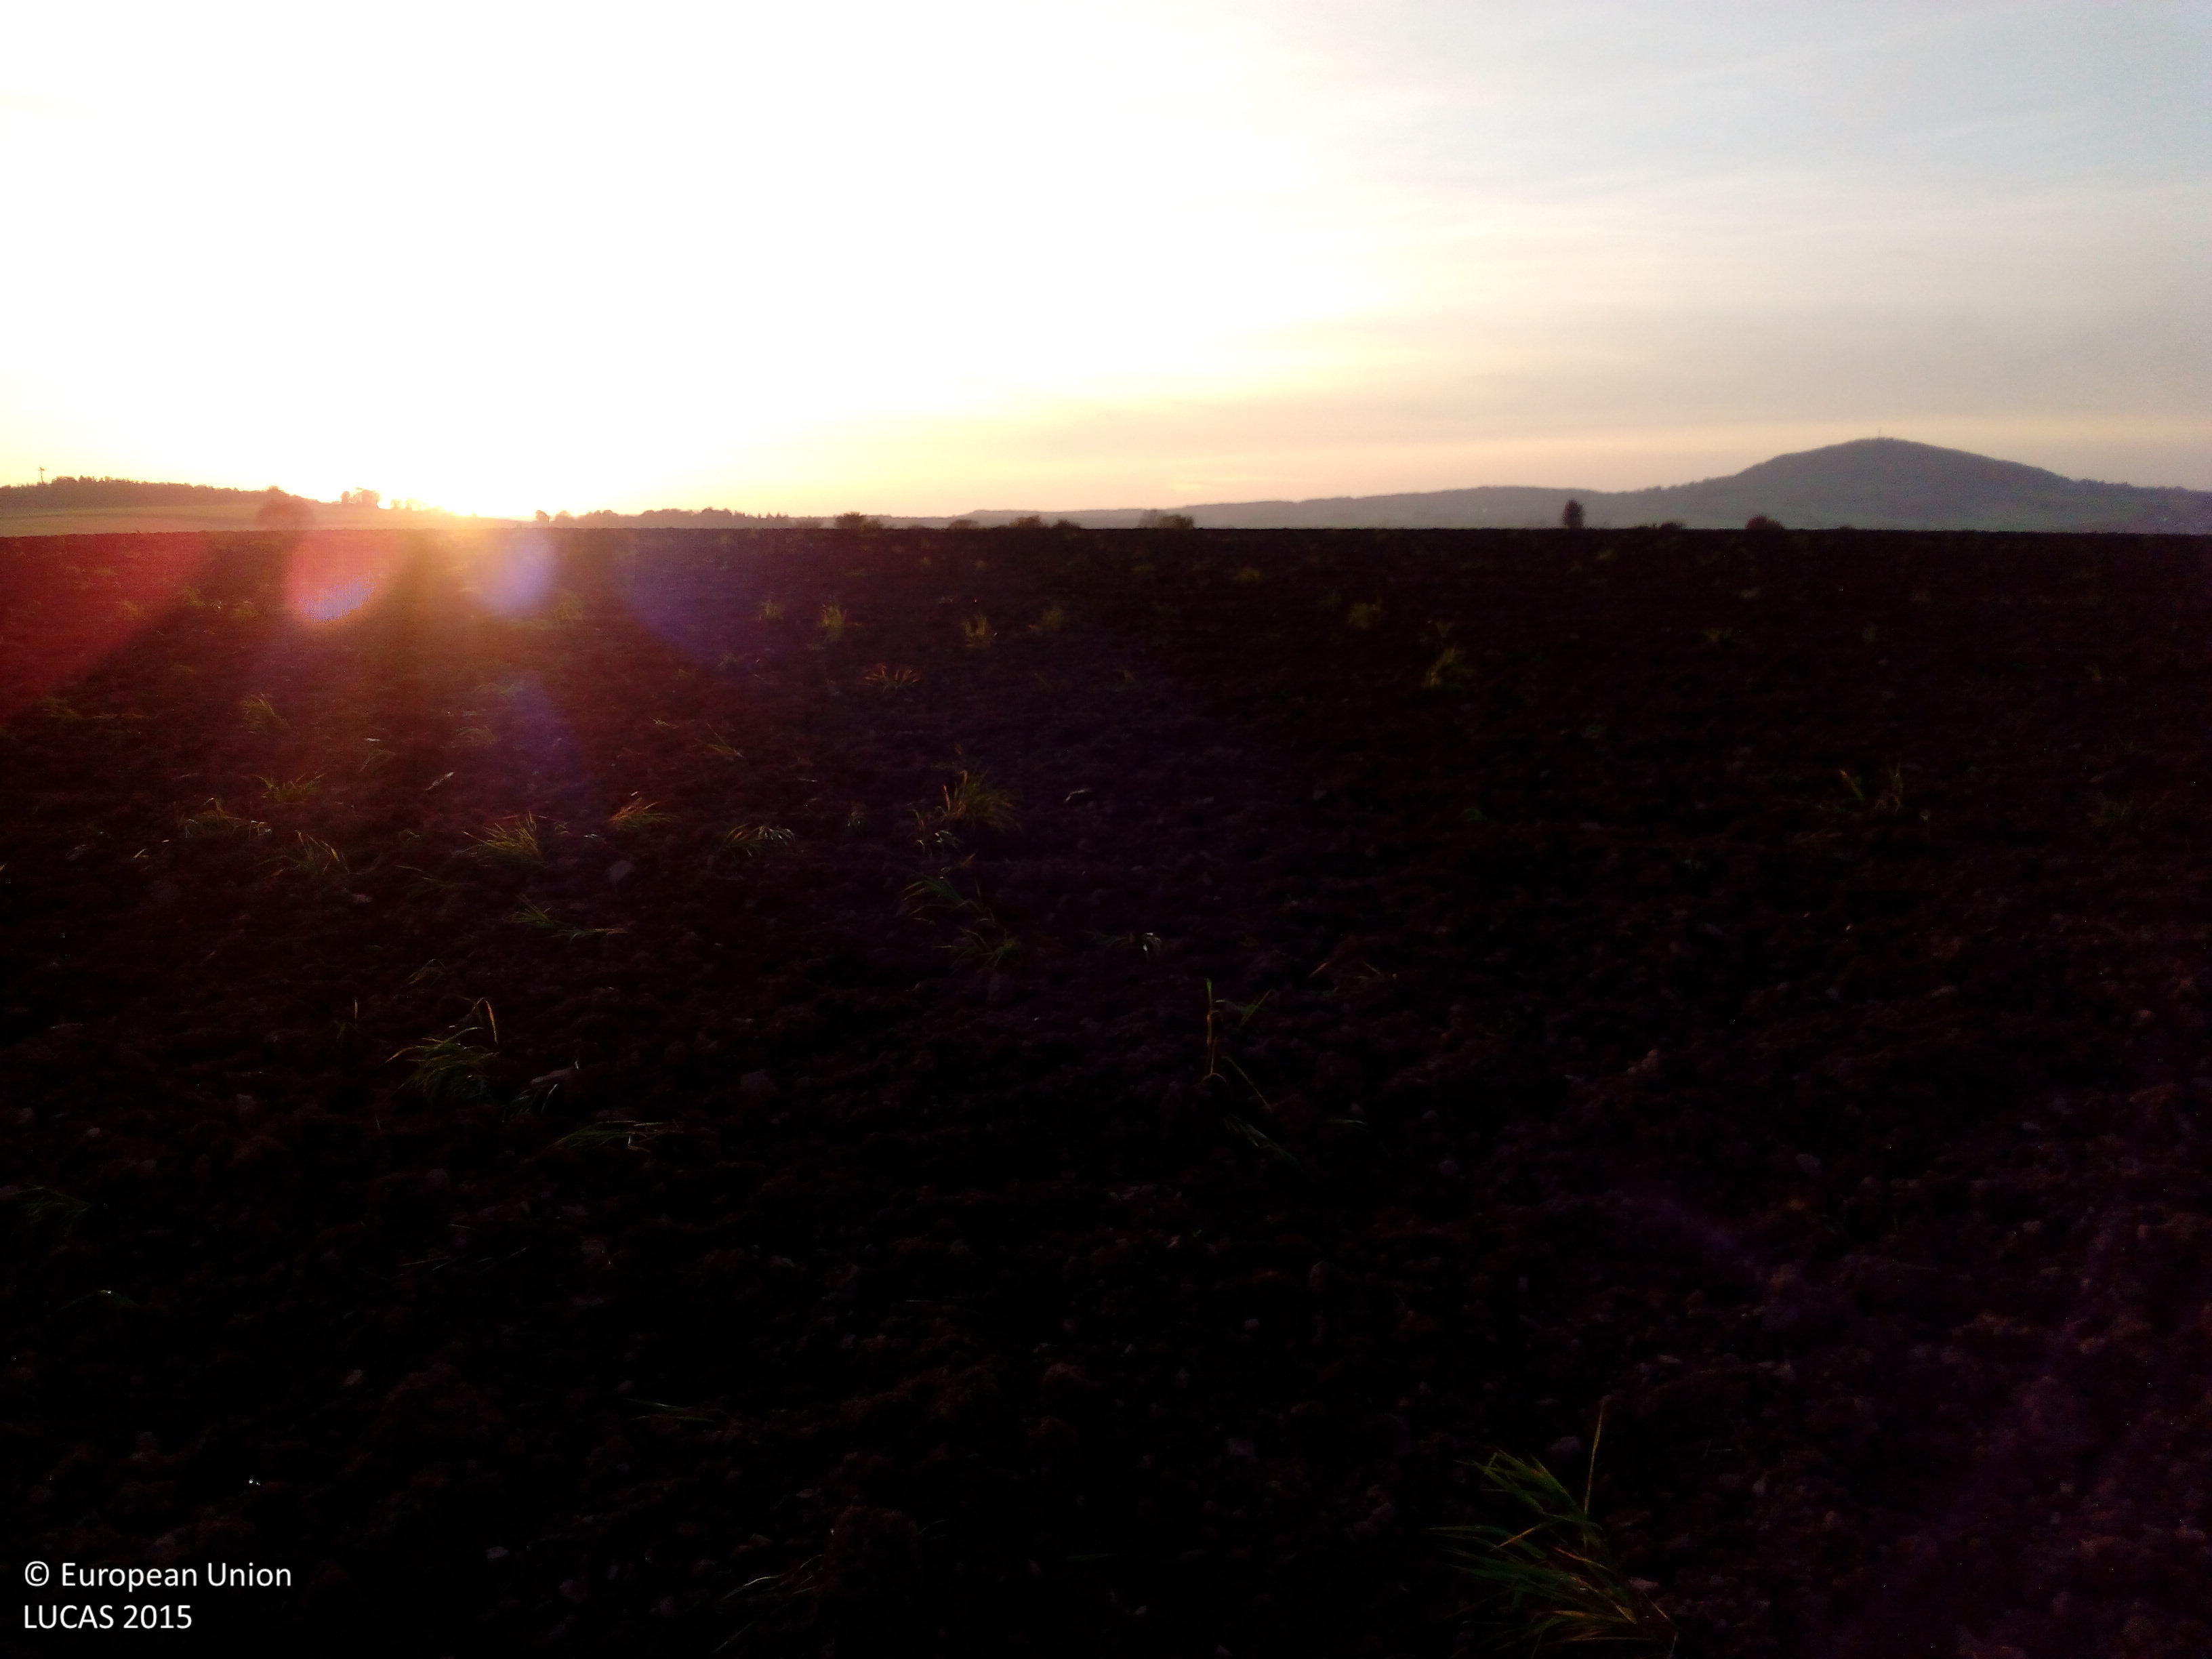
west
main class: Cropland
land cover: Barley
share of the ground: < 10 %
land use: Agriculture (excluding fallow land and kitchen gardens)
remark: Tilled/Sowed
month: October
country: DE
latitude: 50.2561
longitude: 9.8458
